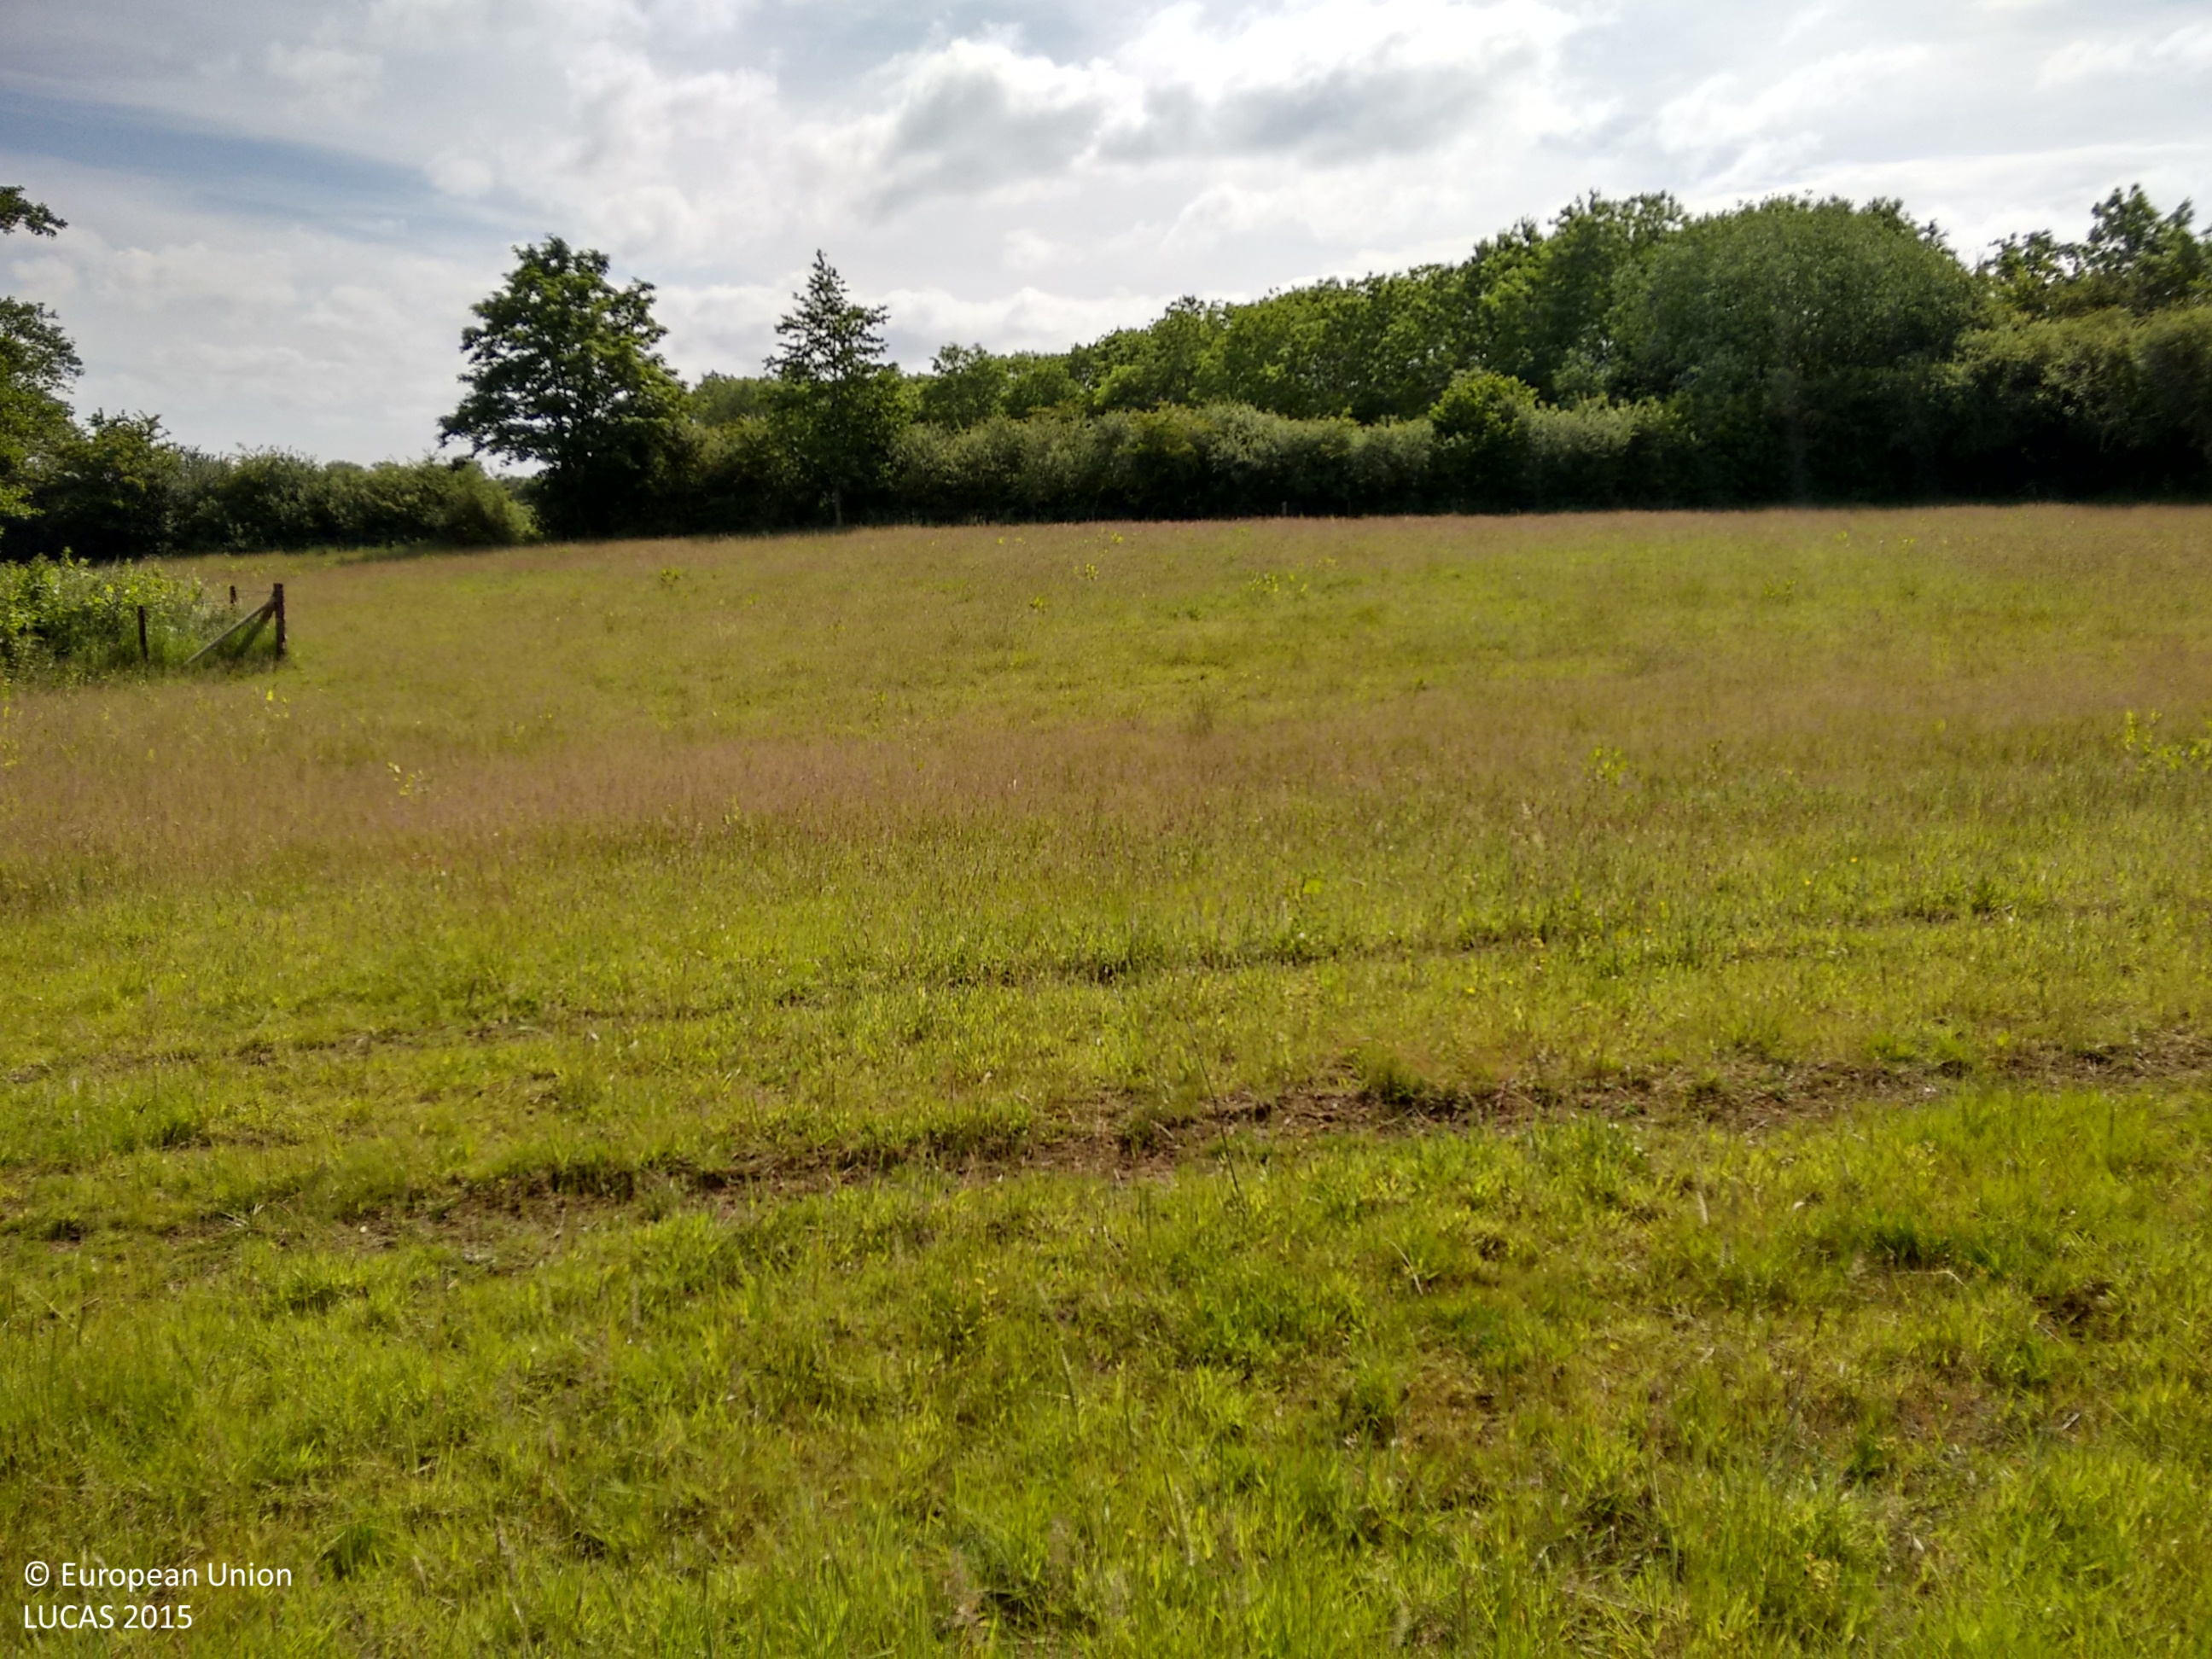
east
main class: Grassland
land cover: Grassland without tree/shrub cover
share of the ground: > 75 %
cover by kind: herbaceous plants 100 %
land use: Agriculture (excluding fallow land and kitchen gardens)
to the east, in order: Abandoned hedges; Grassland without tree/shrub cover; Fences; Ditches and canals; Managed hedges; Grass margins; Dry pulses; Grass margins; Managed hedges; Grass margins; Tracks; Grass margins; Managed hedges; Grass margins; Common wheat; Grass margins; Tracks; Managed hedges; Fences; Grassland without tree/shrub cover
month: June
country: GB
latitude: 53.3452
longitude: -0.0512
